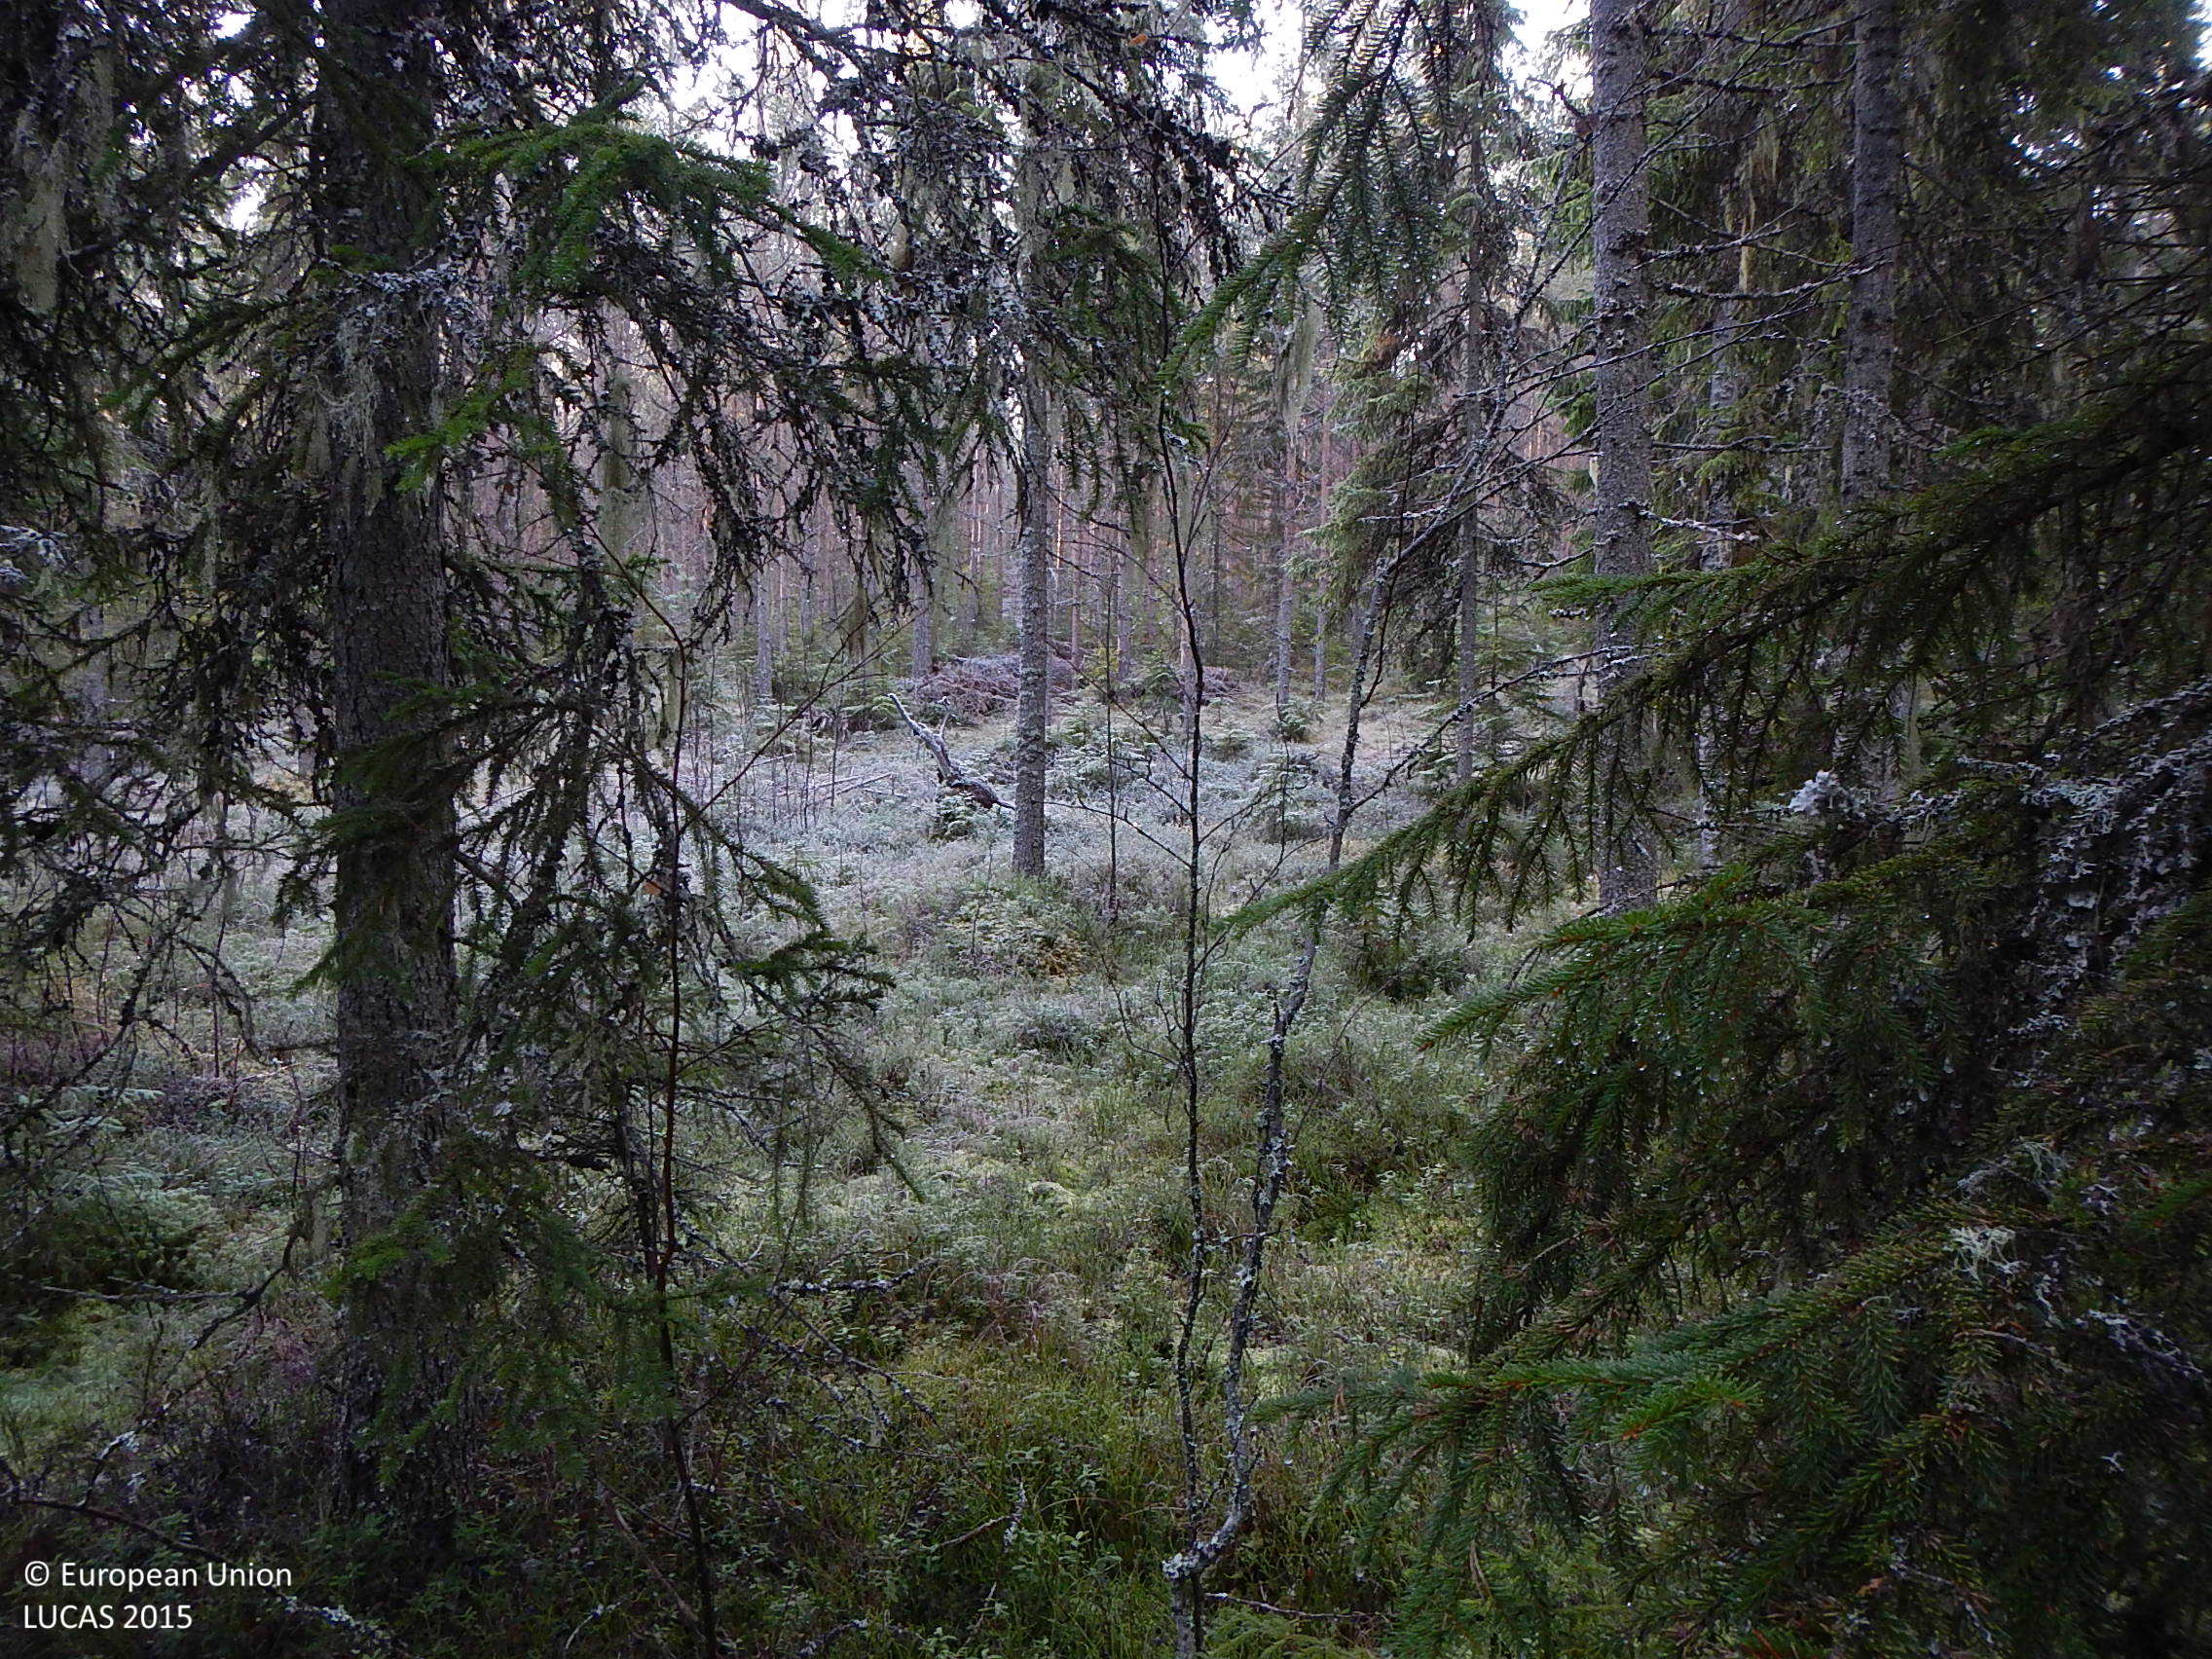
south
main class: Woodland
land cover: Spruce dominated coniferous woodland
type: boreal forest
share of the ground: 50 - 75 %
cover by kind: coniferous forest trees 50 %, shrubs 30 %, lichens and mosses 20 %
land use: Forestry
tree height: > 5 m
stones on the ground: < 10 %
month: November
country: SE
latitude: 61.5920
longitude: 15.9188
